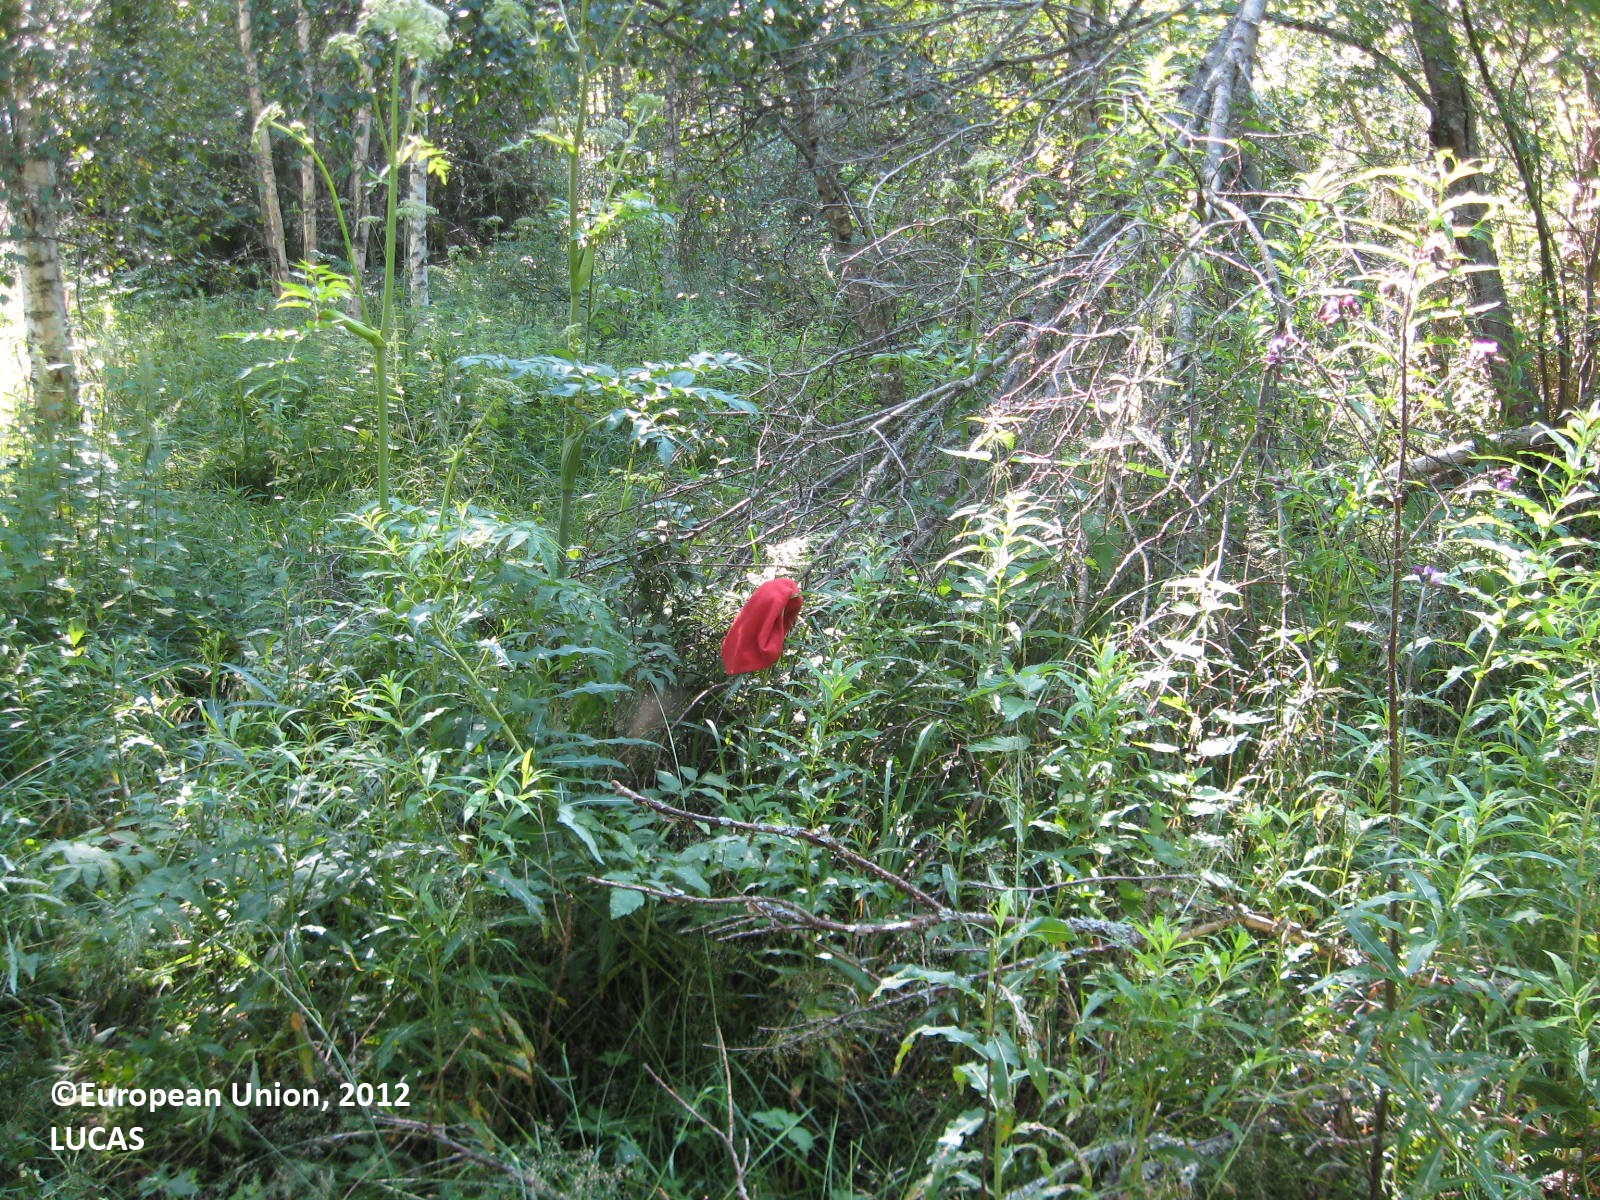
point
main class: Woodland
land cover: Broadleaved woodland
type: boreal forest
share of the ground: > 75 %
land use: Forestry
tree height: > 5 m
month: July
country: FI
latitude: 61.8700
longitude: 22.7072
